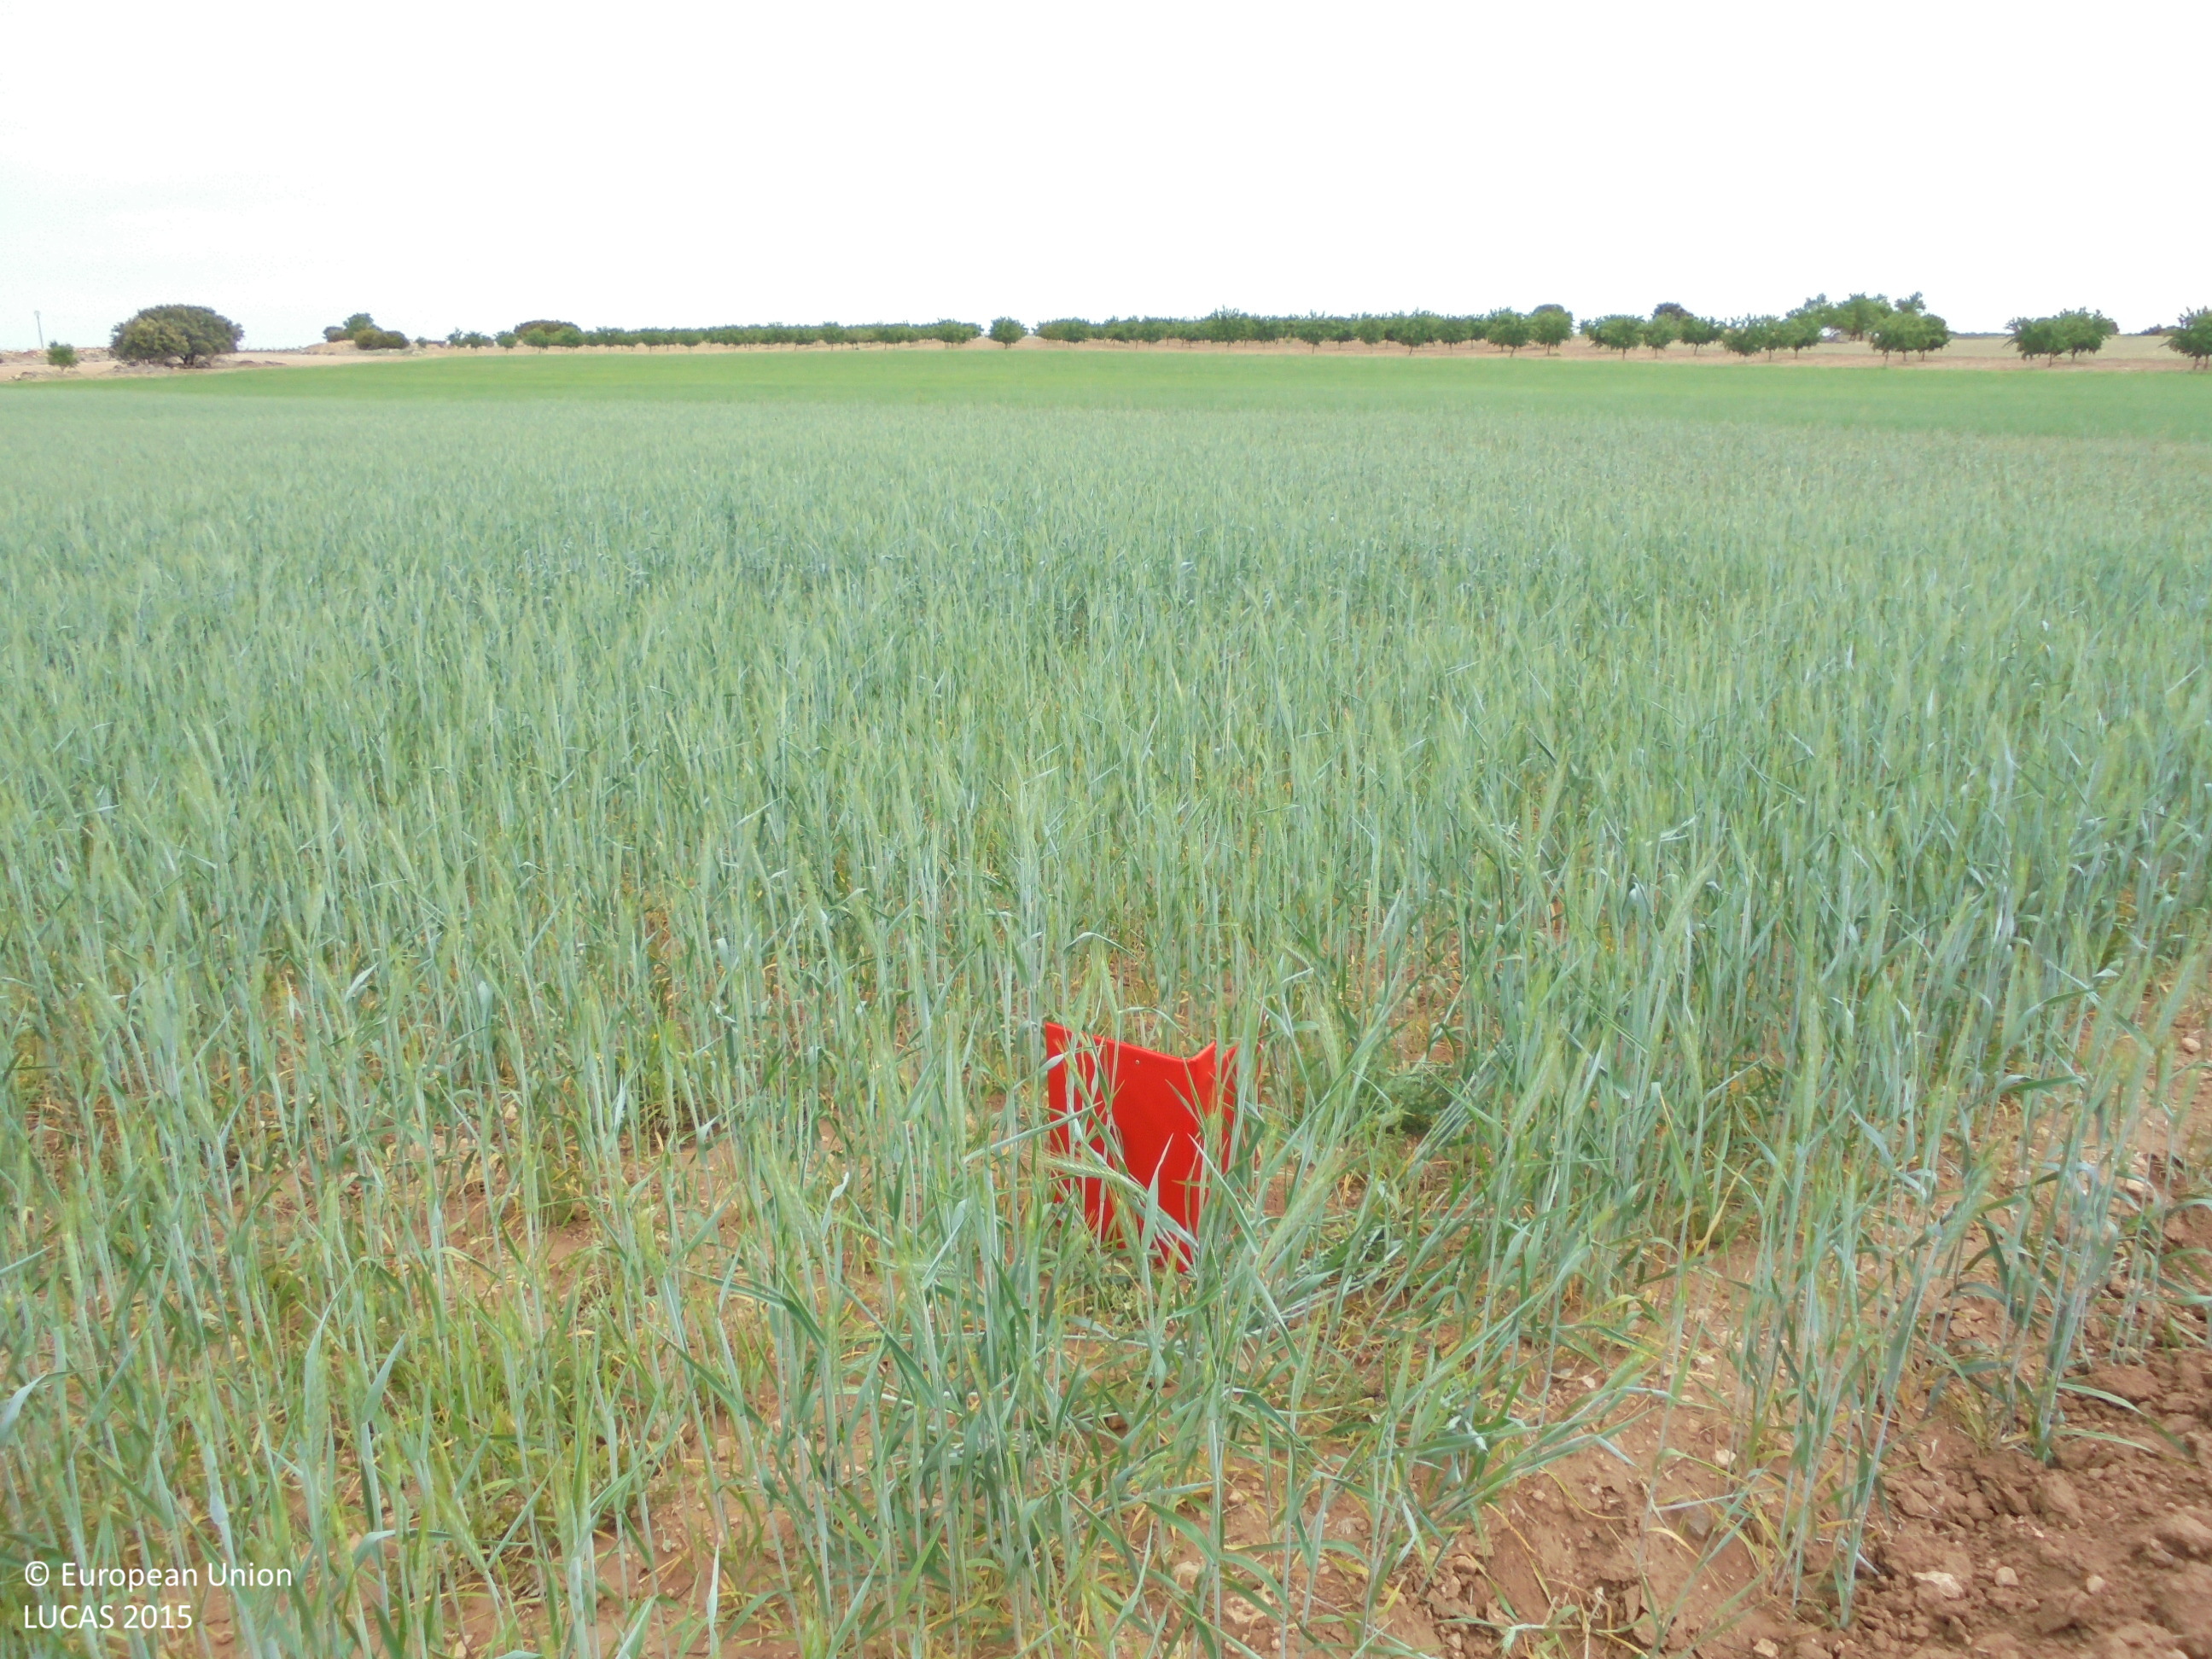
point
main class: Cropland
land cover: Durum wheat
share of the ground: > 75 %
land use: Agriculture (excluding fallow land and kitchen gardens)
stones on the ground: 10 - 25 %
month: May
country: ES
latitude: 39.2520
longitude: -1.7180
